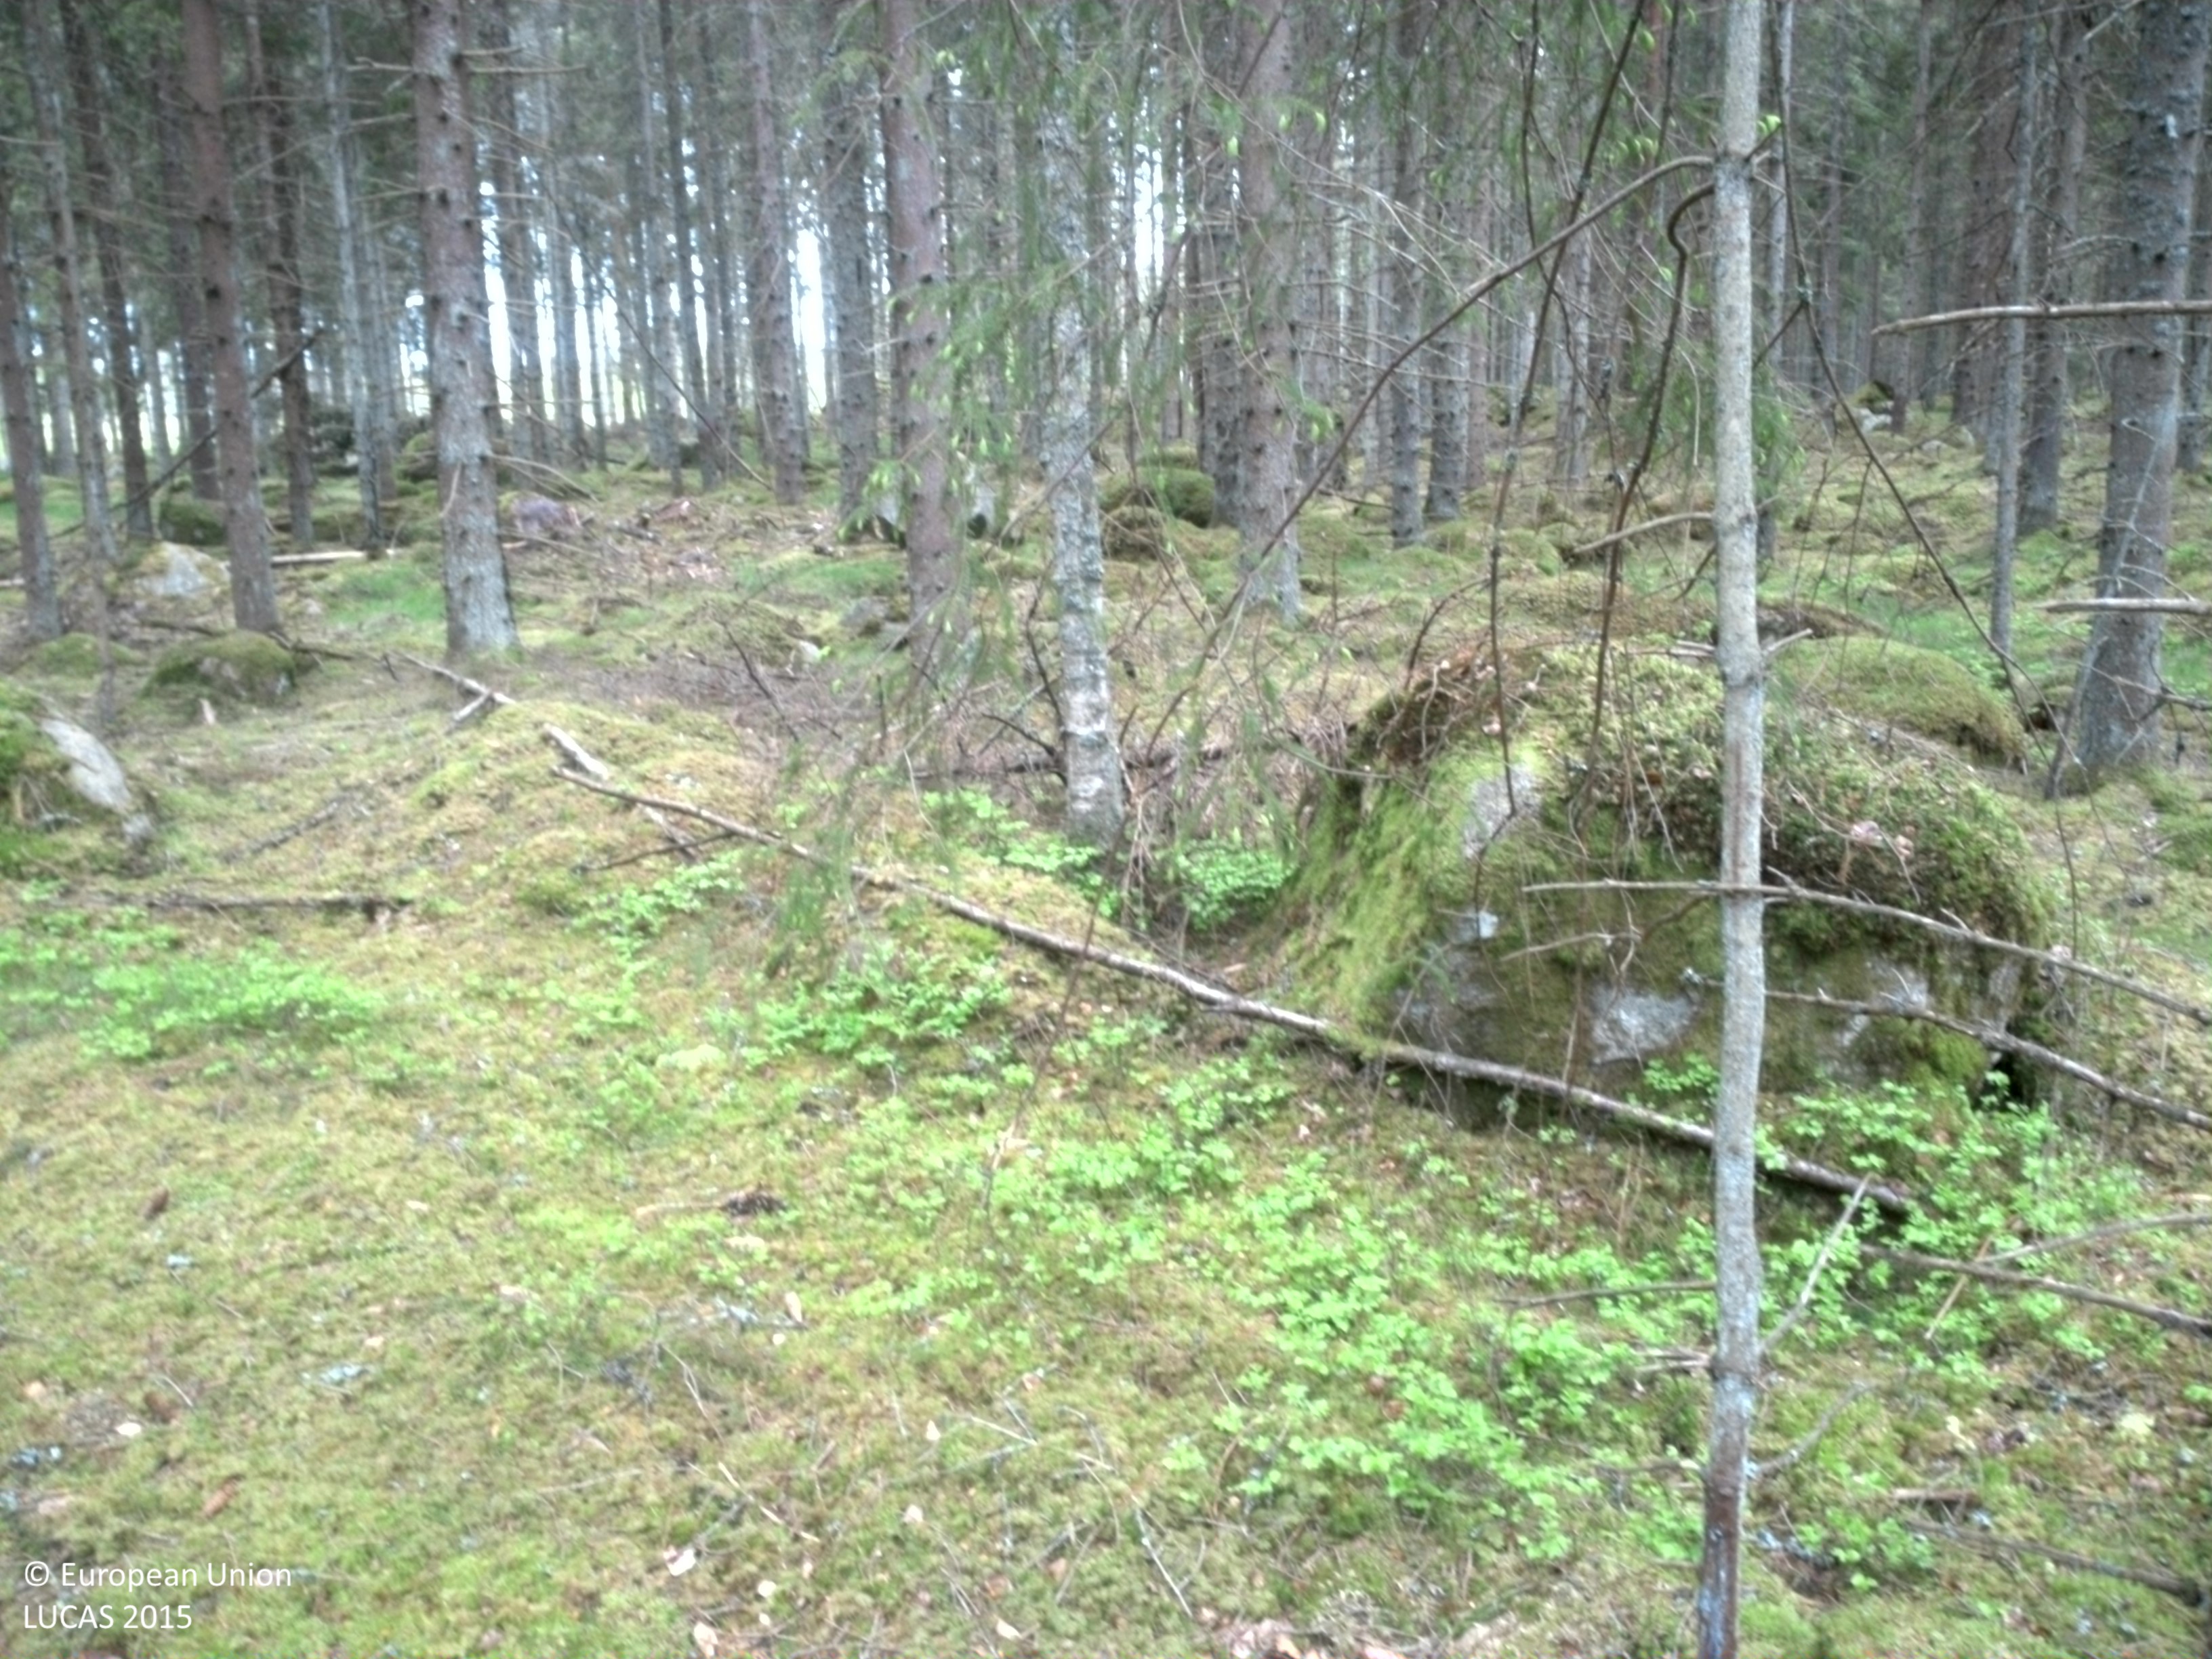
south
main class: Woodland
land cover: Spruce dominated coniferous woodland
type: boreal forest
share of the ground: > 75 %
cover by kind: coniferous forest trees 85 %, lichens and mosses 10 %, broadleaved forest trees 5 %
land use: Forestry
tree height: > 5 m
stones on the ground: < 10 %
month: May
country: SE
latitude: 56.5540
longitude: 15.1228
